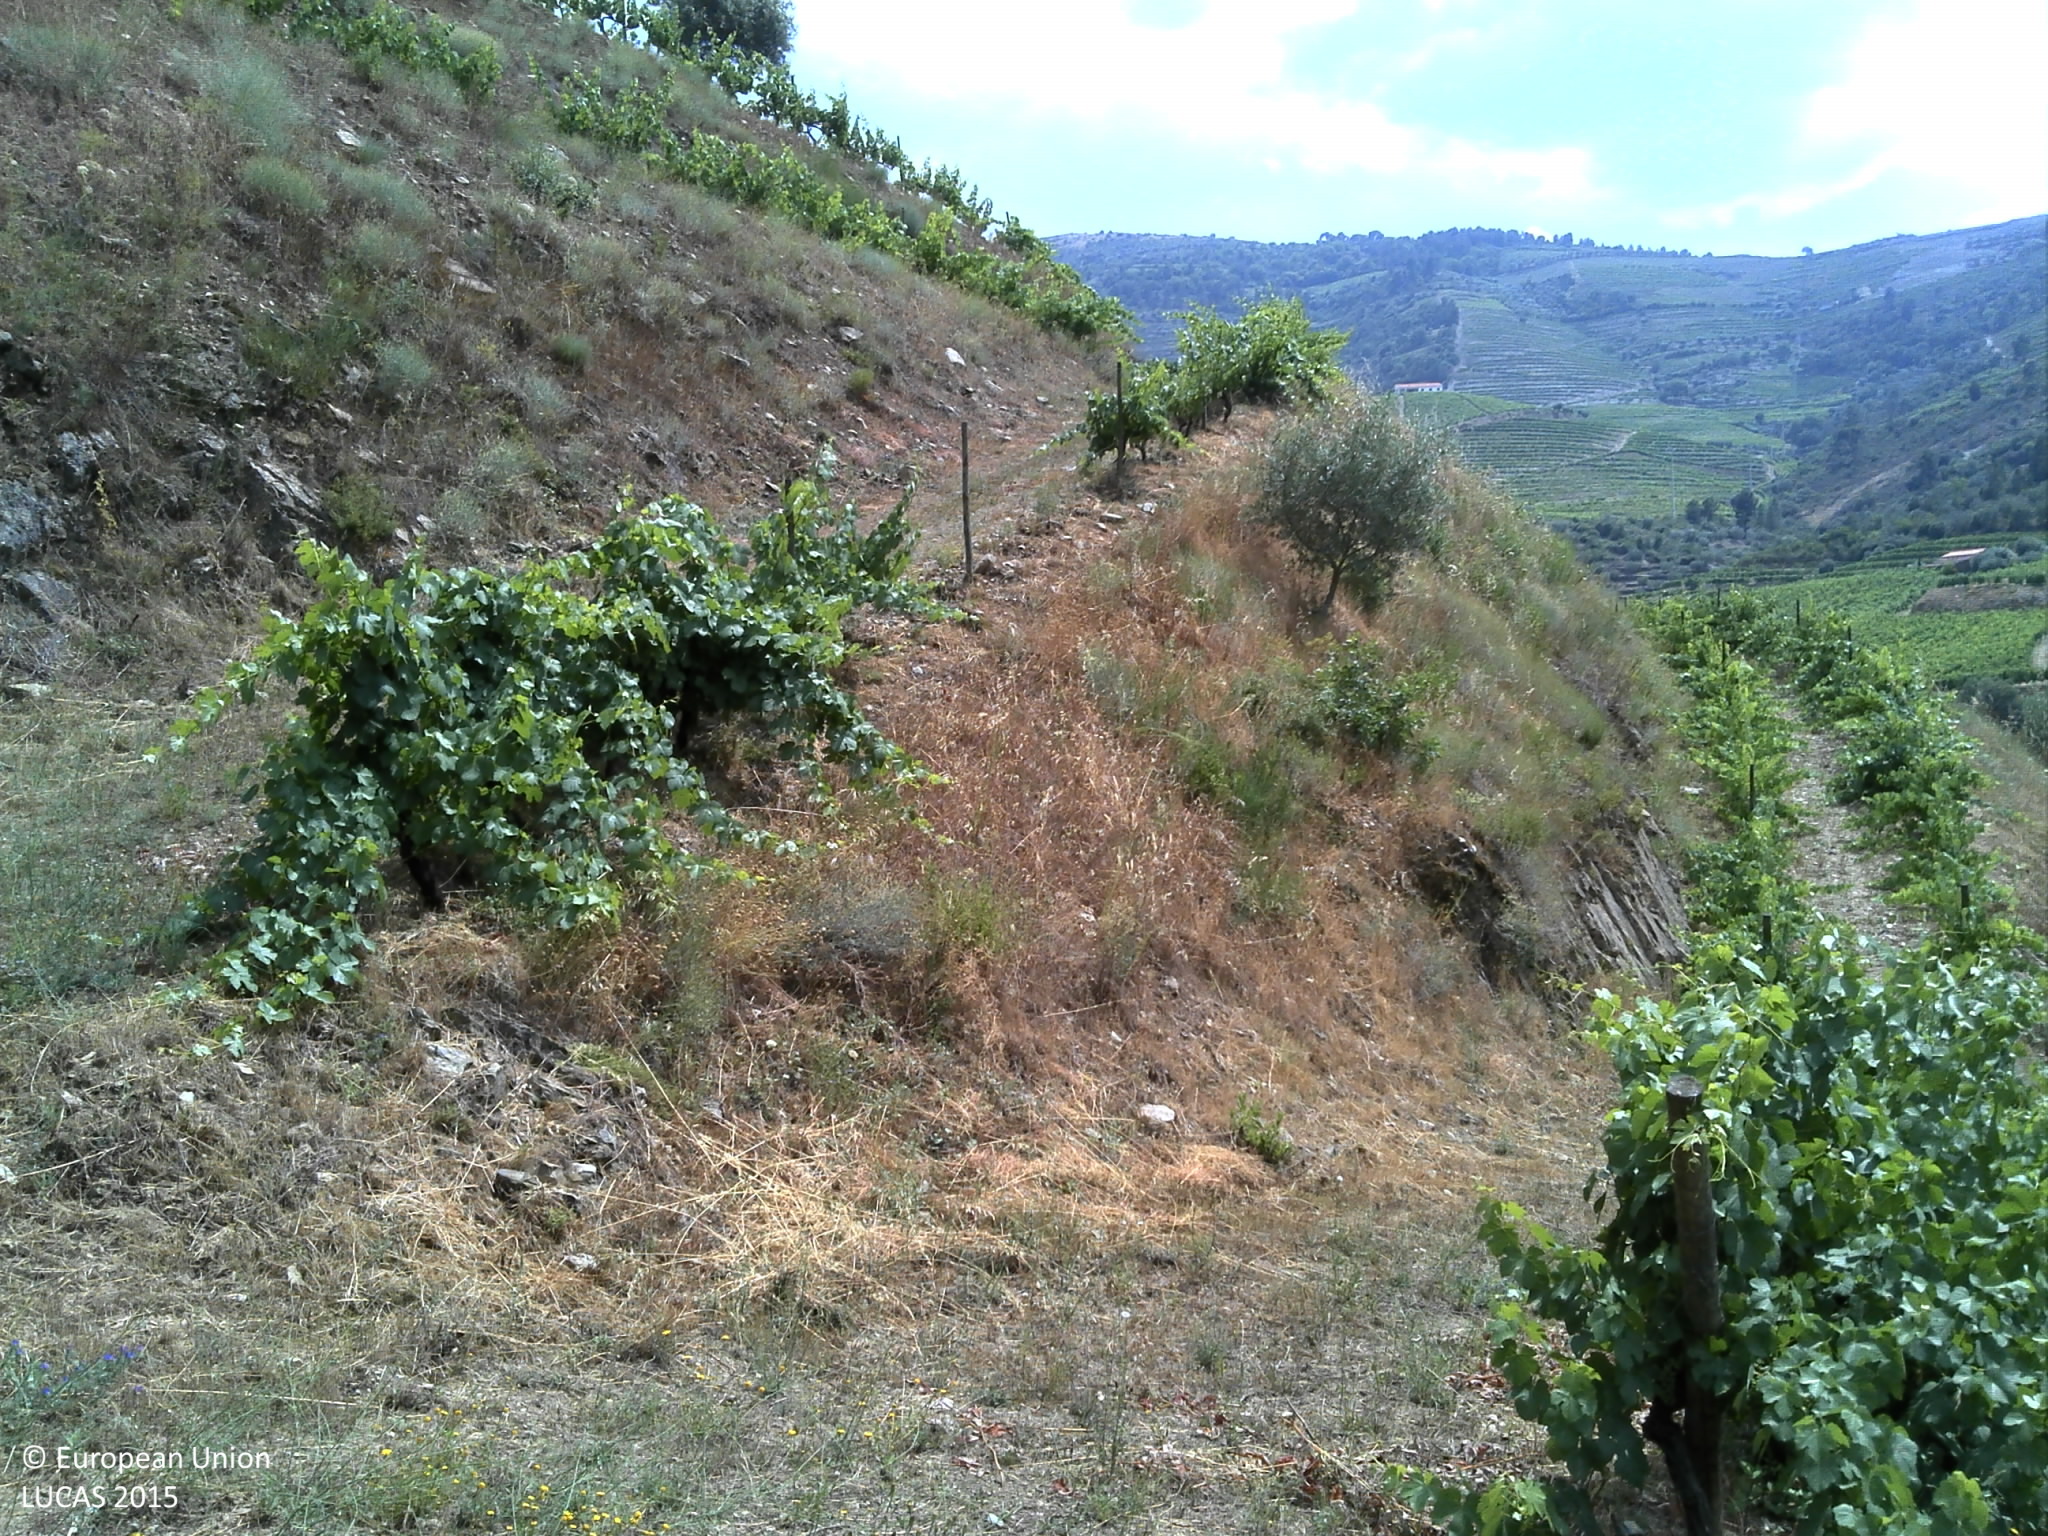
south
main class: Cropland
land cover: Olive groves
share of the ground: < 10 %
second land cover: Shrubland without tree cover
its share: 50 - 75 %
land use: Abandoned areas
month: June
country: PT
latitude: 41.1386
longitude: -7.4789
